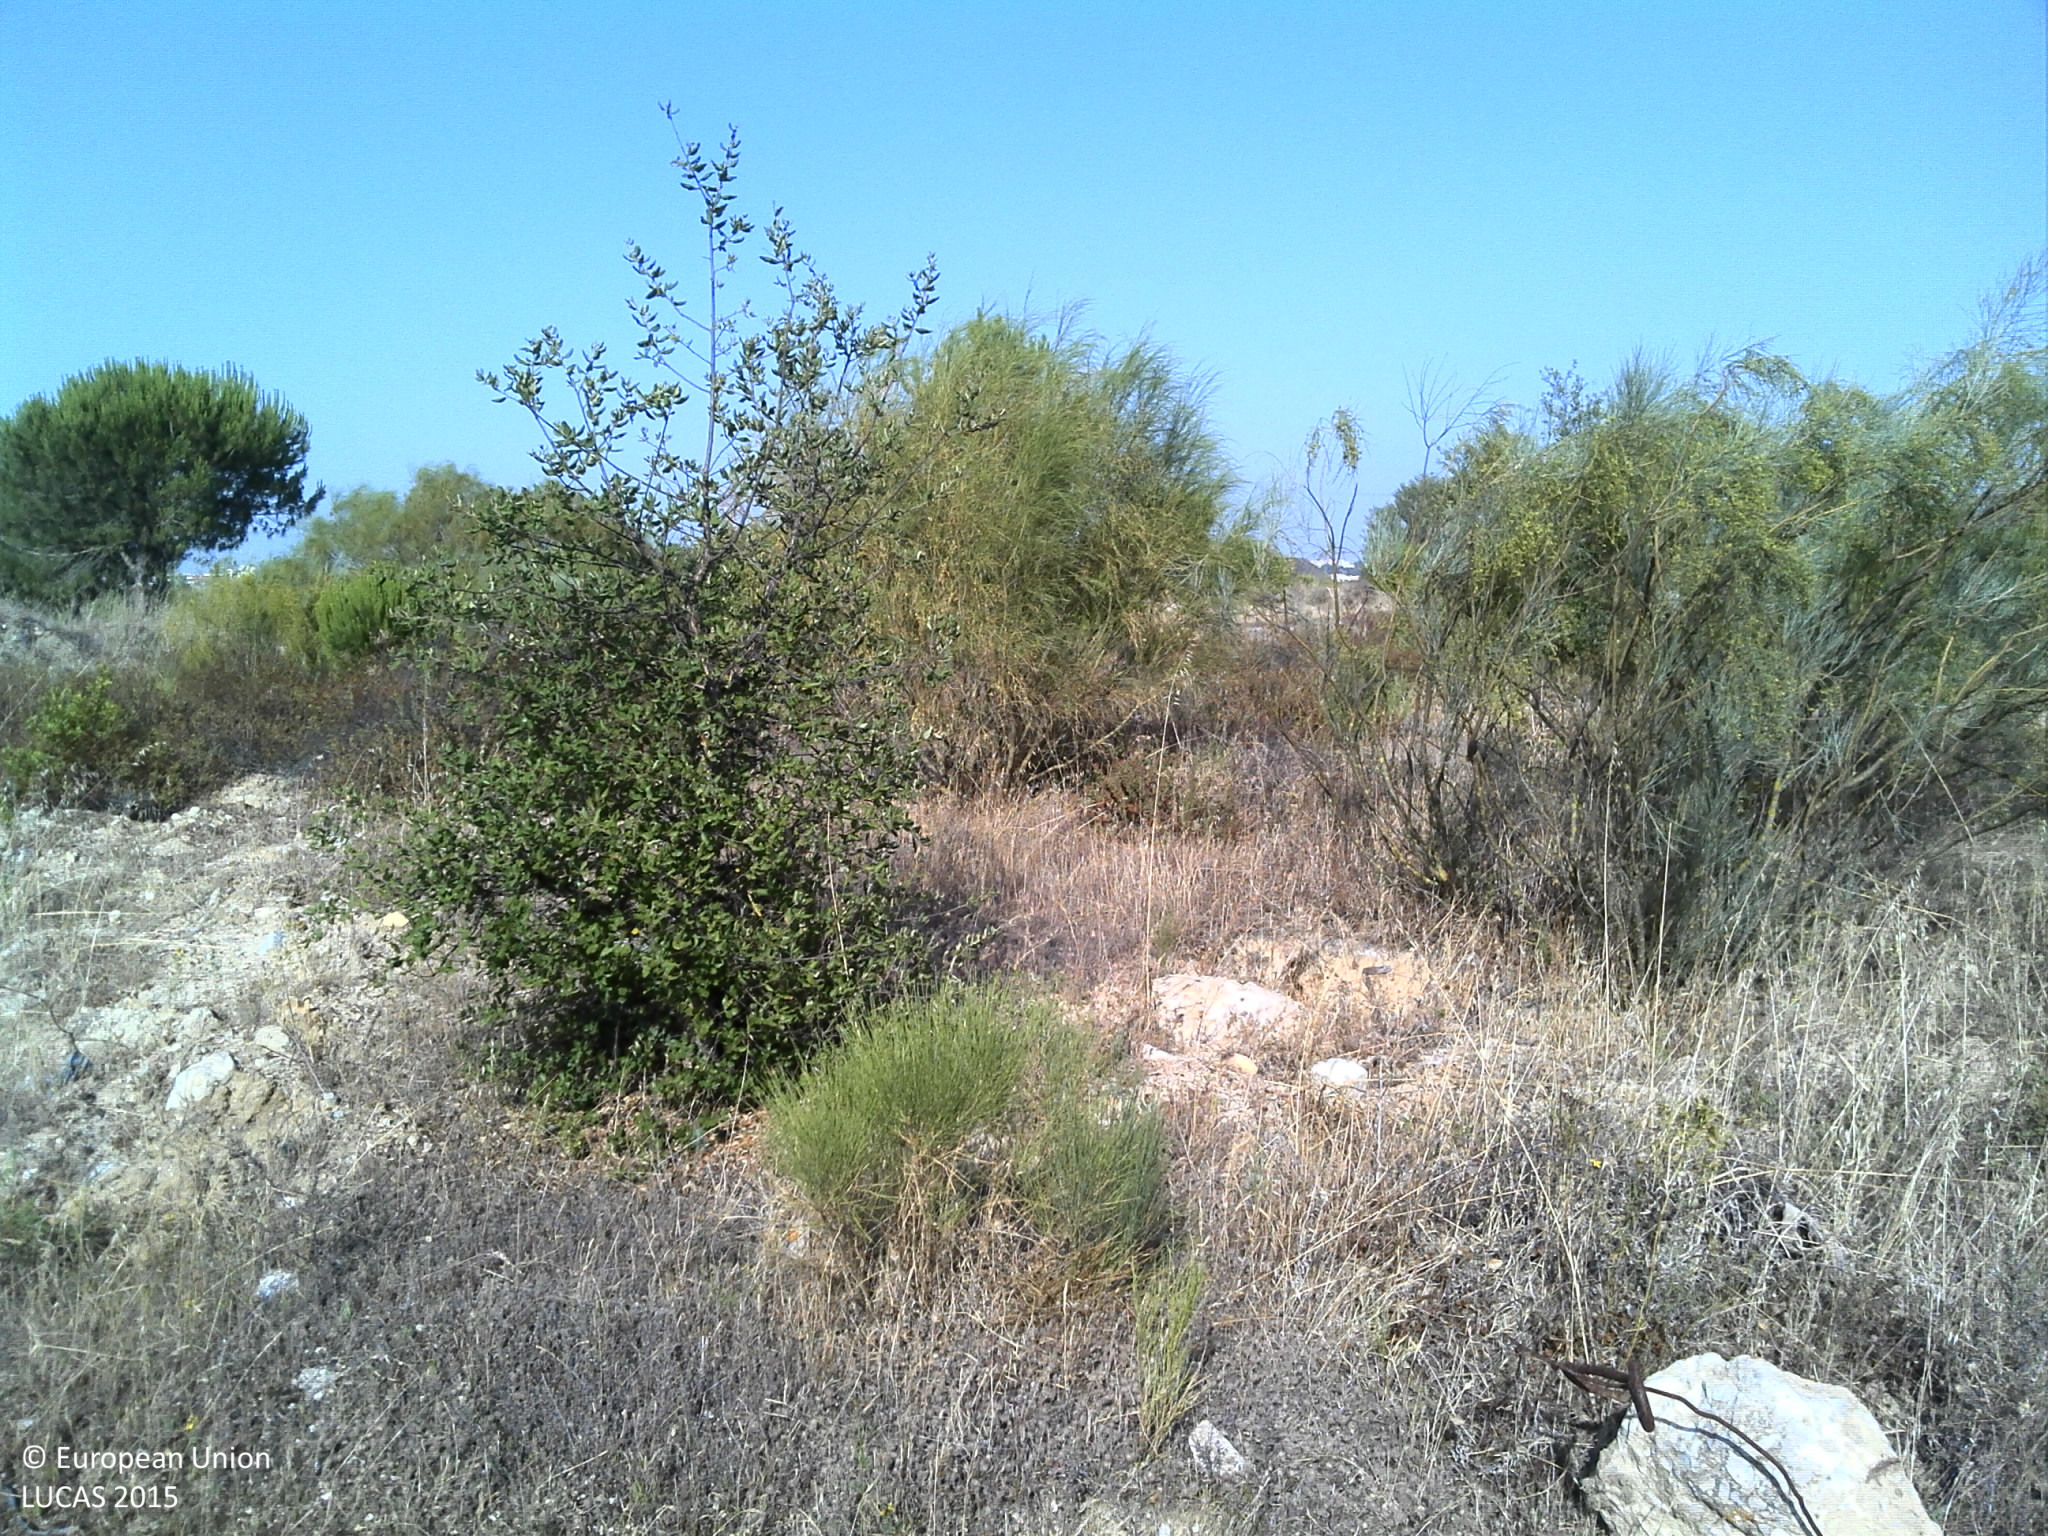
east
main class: Grassland
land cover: Grassland with sparse tree/shrub cover
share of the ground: 25 - 50 %
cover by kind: unconsolidated bare surface 60 %, herbaceous plants 30 %, broadleaved forest trees 5 %, shrubs 5 %
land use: Abandoned areas
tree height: < 5 m
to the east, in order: Grassland with sparse tree/shrub cover; Tracks; Grassland with sparse tree/shrub cover; Other bare soil; Grassland with sparse tree/shrub cover; Paved roads, cycling and walking lanes; Ponds and wetlands; Broadleaved woodland; Grassland with sparse tree/shrub cover
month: June
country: PT
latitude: 38.6337
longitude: -9.0839
